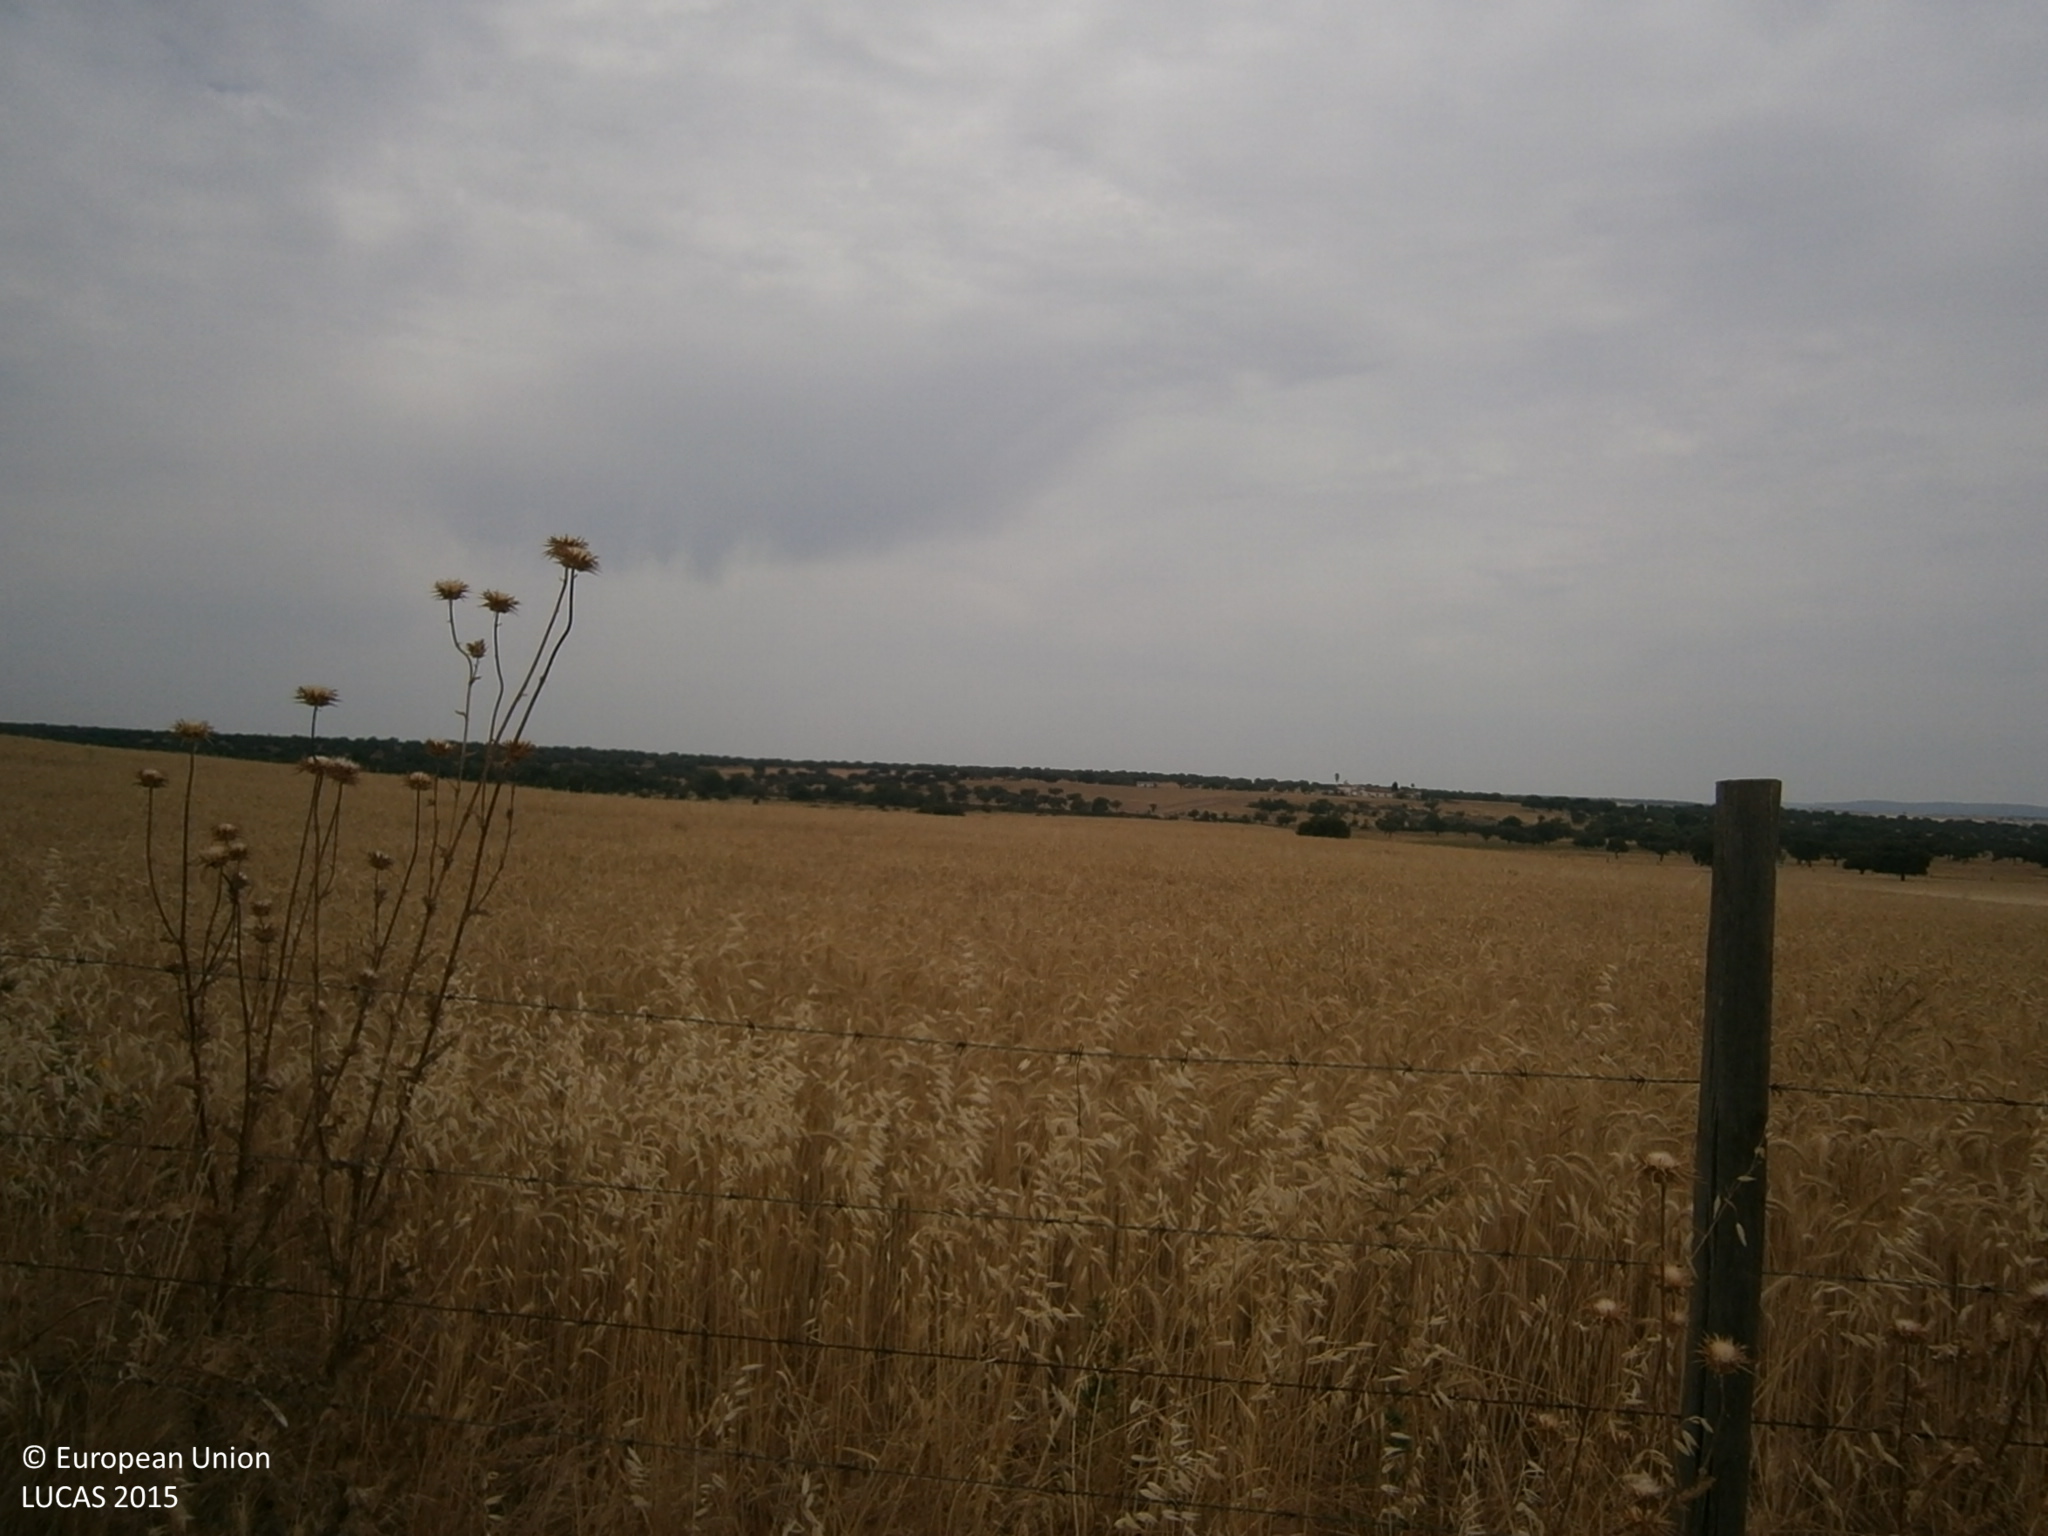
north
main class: Cropland
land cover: Durum wheat
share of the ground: > 75 %
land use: Agriculture (excluding fallow land and kitchen gardens)
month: June
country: ES
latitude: 38.9939
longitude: -6.4679
